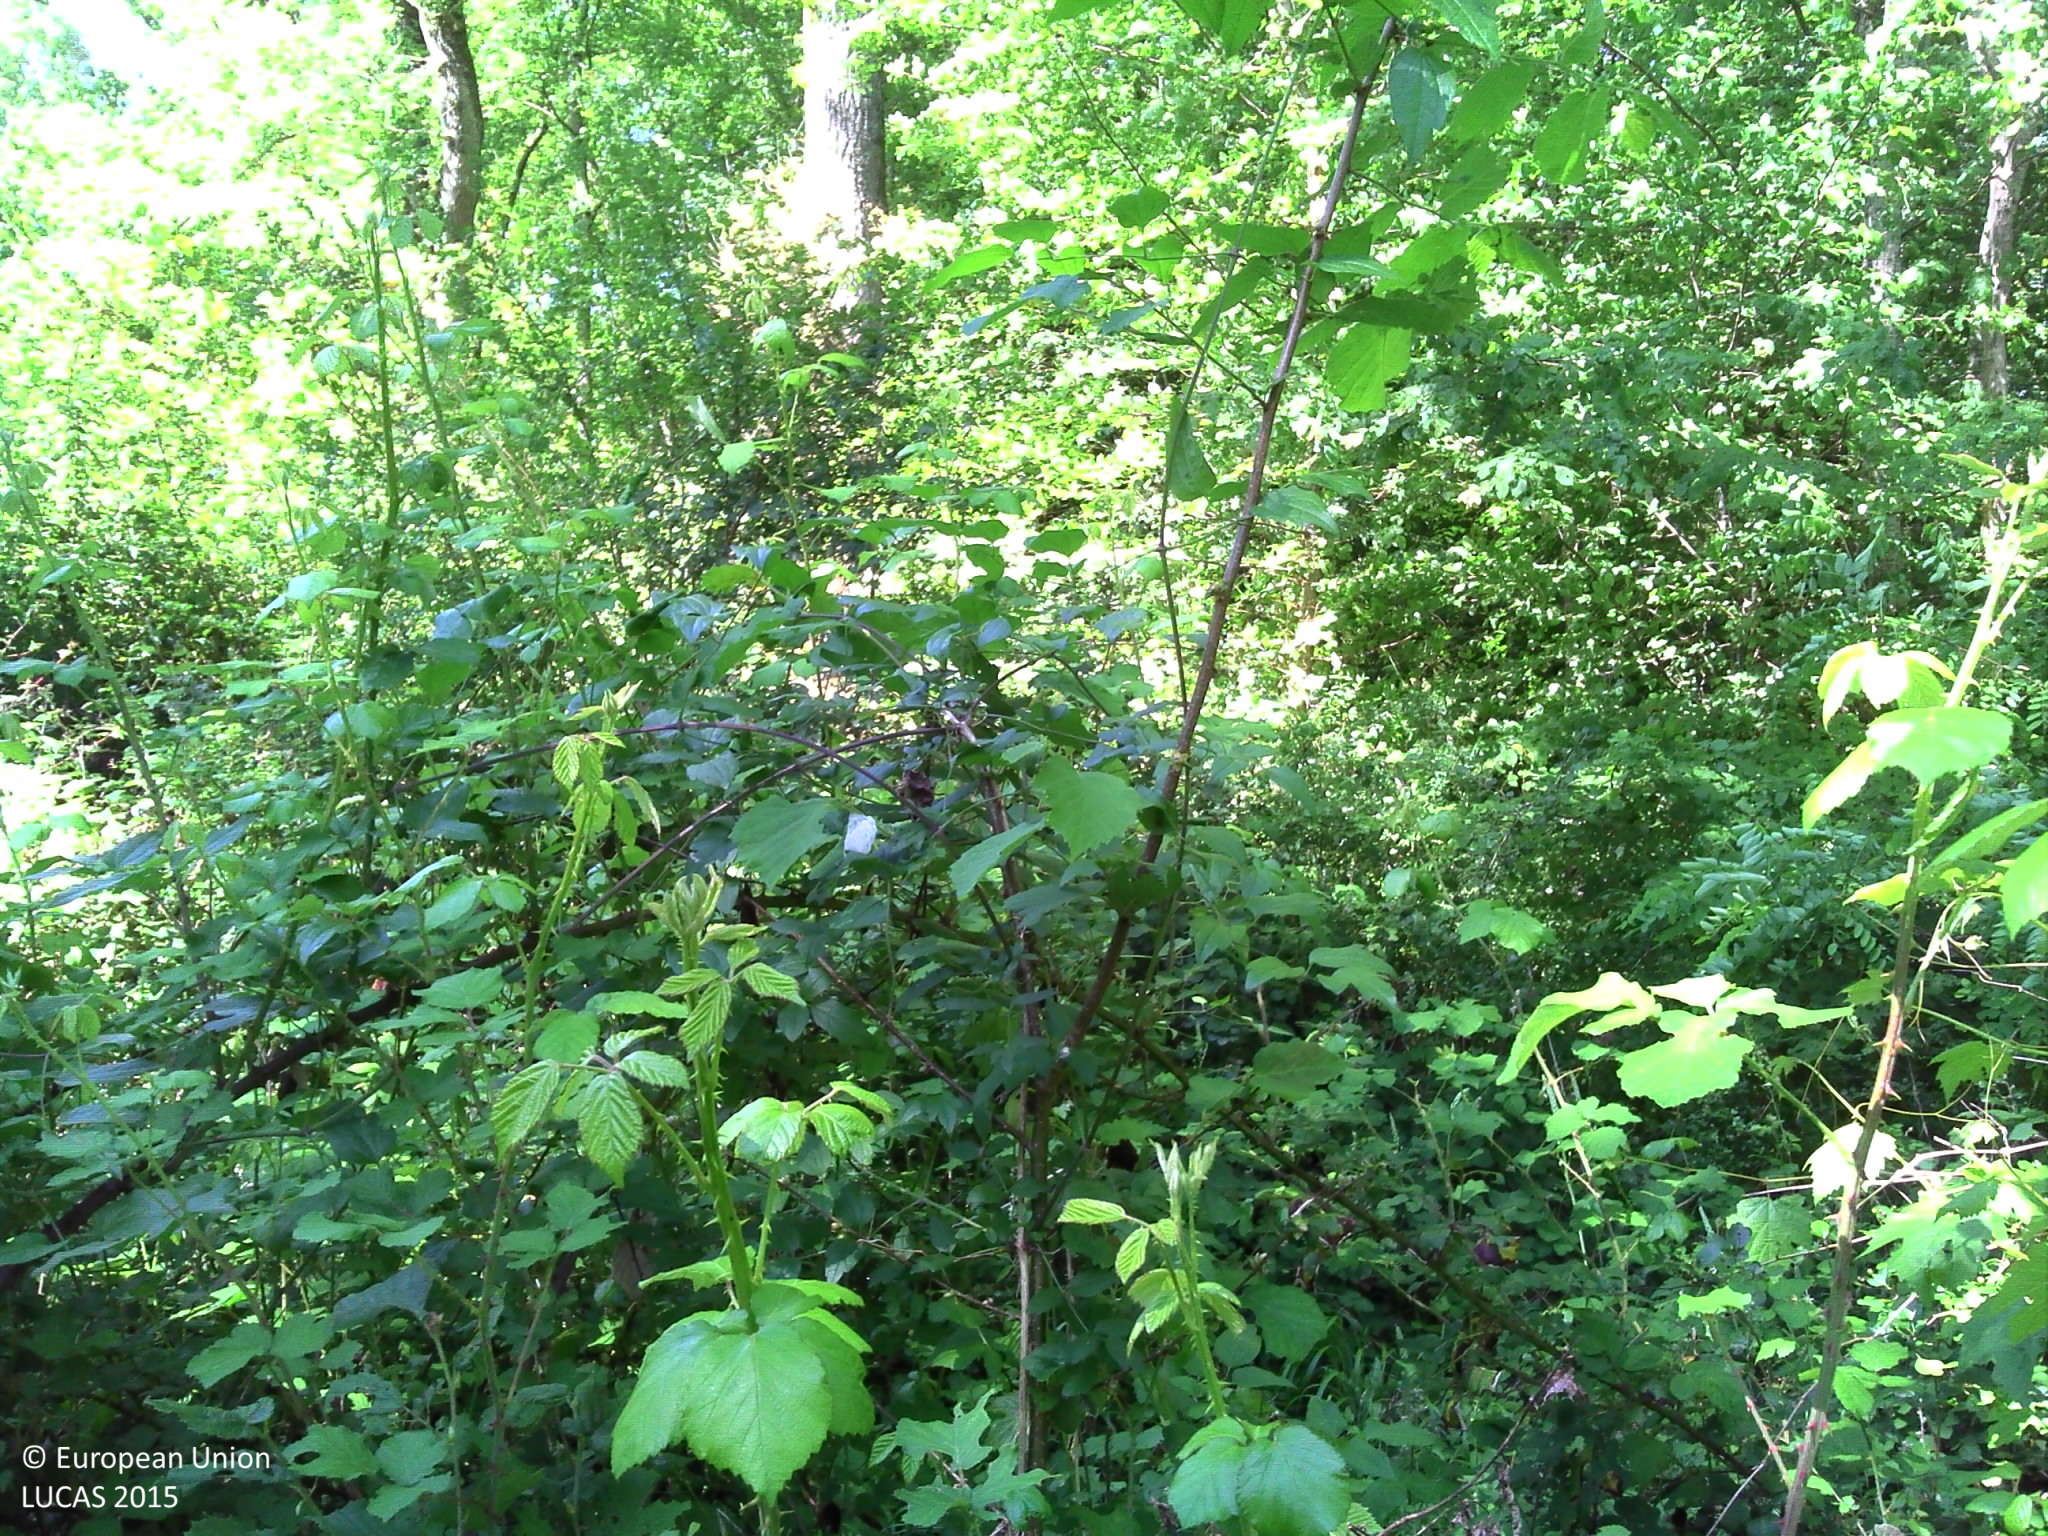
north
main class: Woodland
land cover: Broadleaved woodland
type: acidophilous oak and oak-birch forest
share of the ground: > 75 %
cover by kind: broadleaved forest trees 90 %, shrubs 10 %
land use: Forestry
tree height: > 5 m
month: June
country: FR
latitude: 47.0284
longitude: 2.7708
